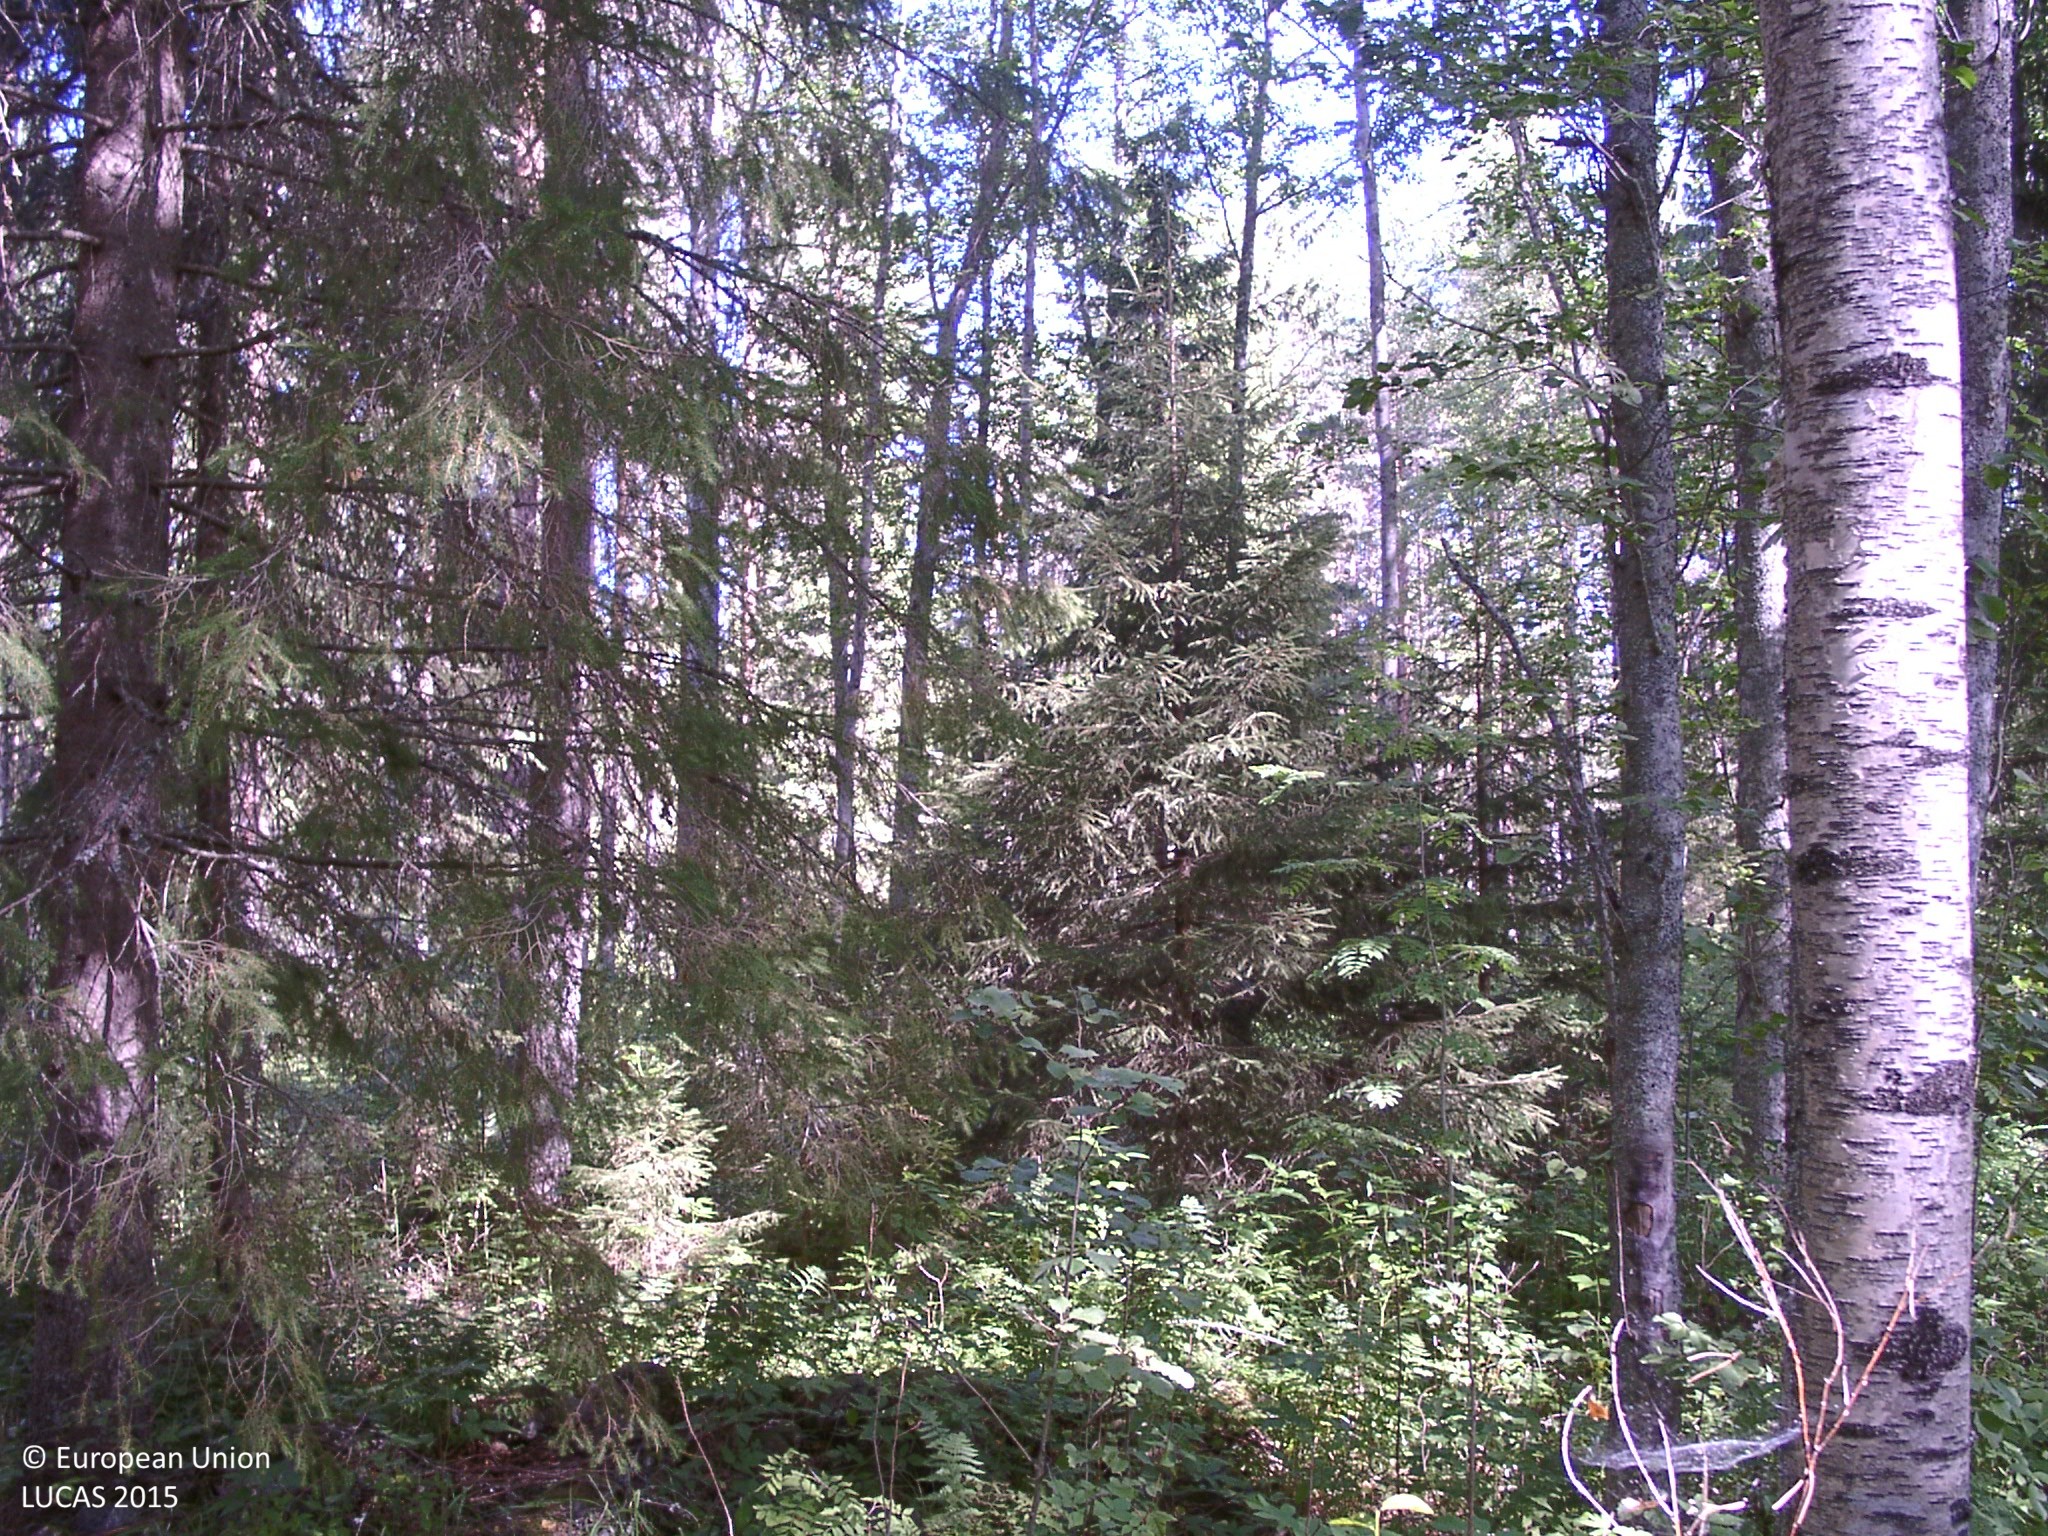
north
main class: Woodland
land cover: Spruce dominated mixed woodland
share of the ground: 50 - 75 %
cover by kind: broadleaved forest trees 50 %, herbaceous plants 25 %, coniferous forest trees 20 %, lichens and mosses 5 %
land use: Forestry
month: August
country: FI
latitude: 62.4034
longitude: 25.2185
